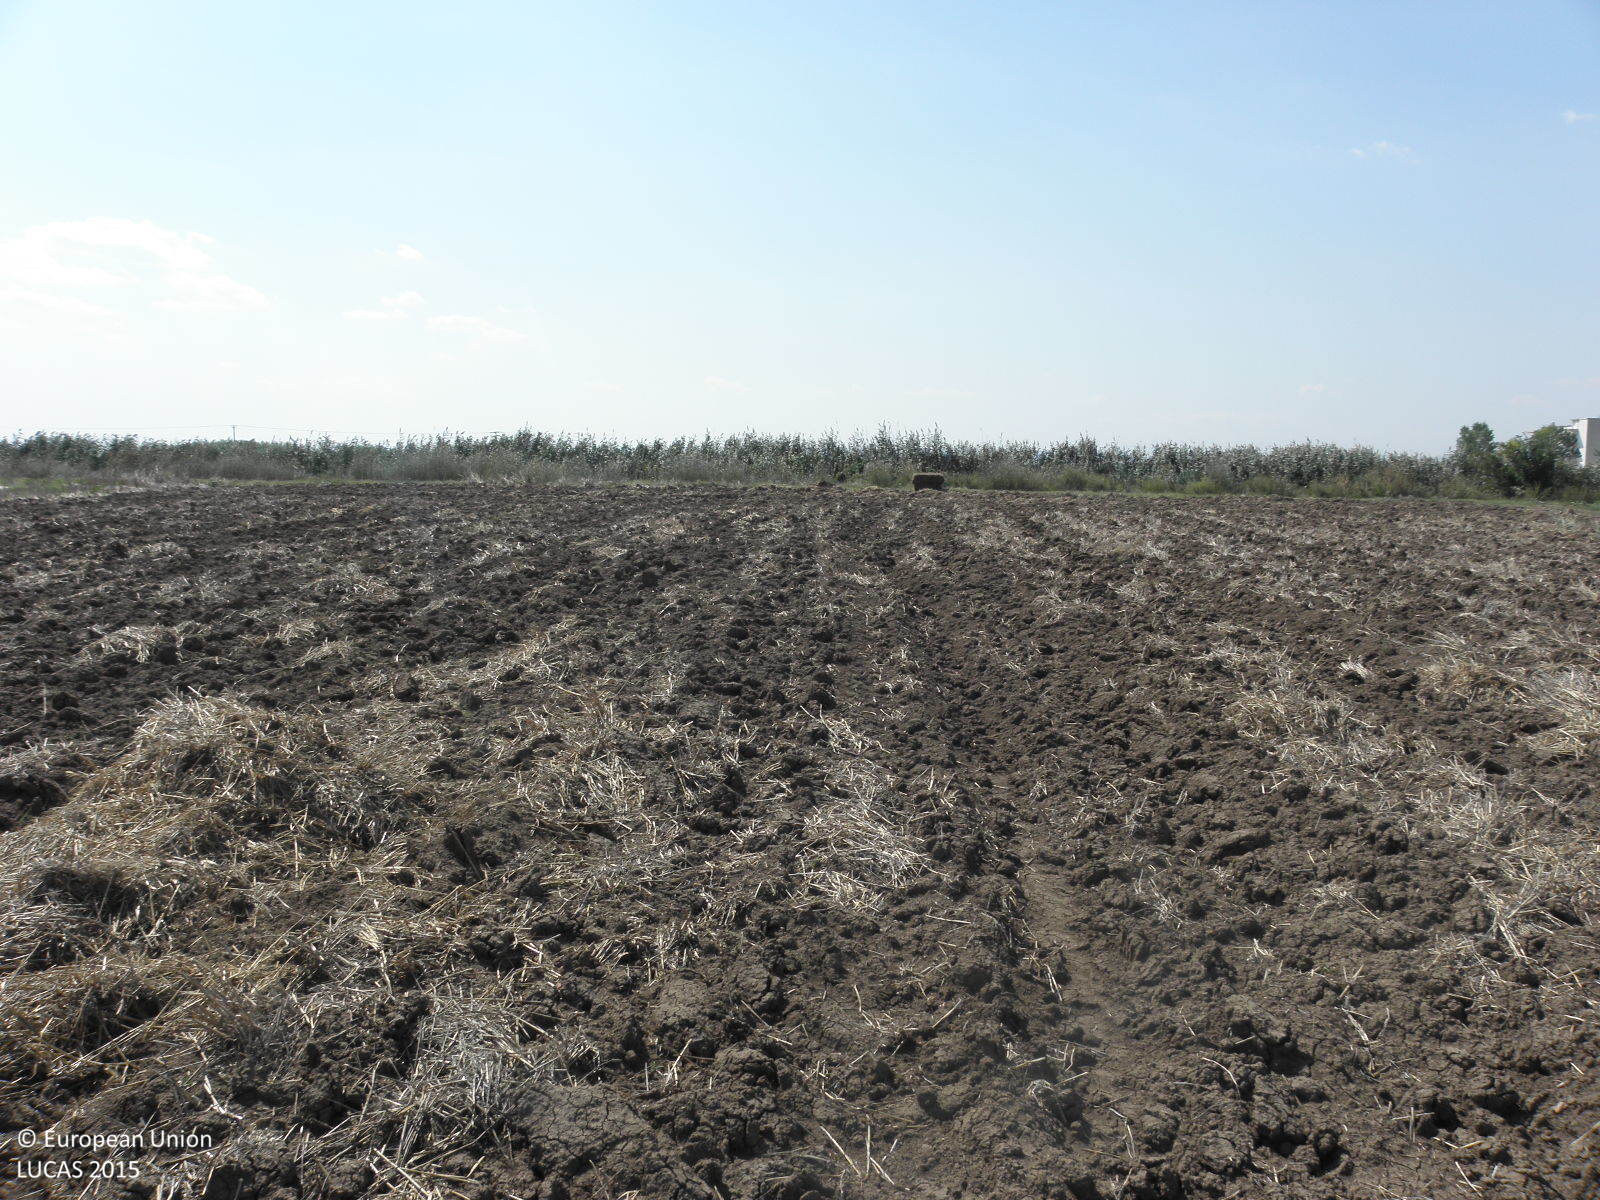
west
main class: Cropland
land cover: Barley
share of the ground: > 75 %
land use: Agriculture (excluding fallow land and kitchen gardens)
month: August
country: GR
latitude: 39.6450
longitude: 22.5180
